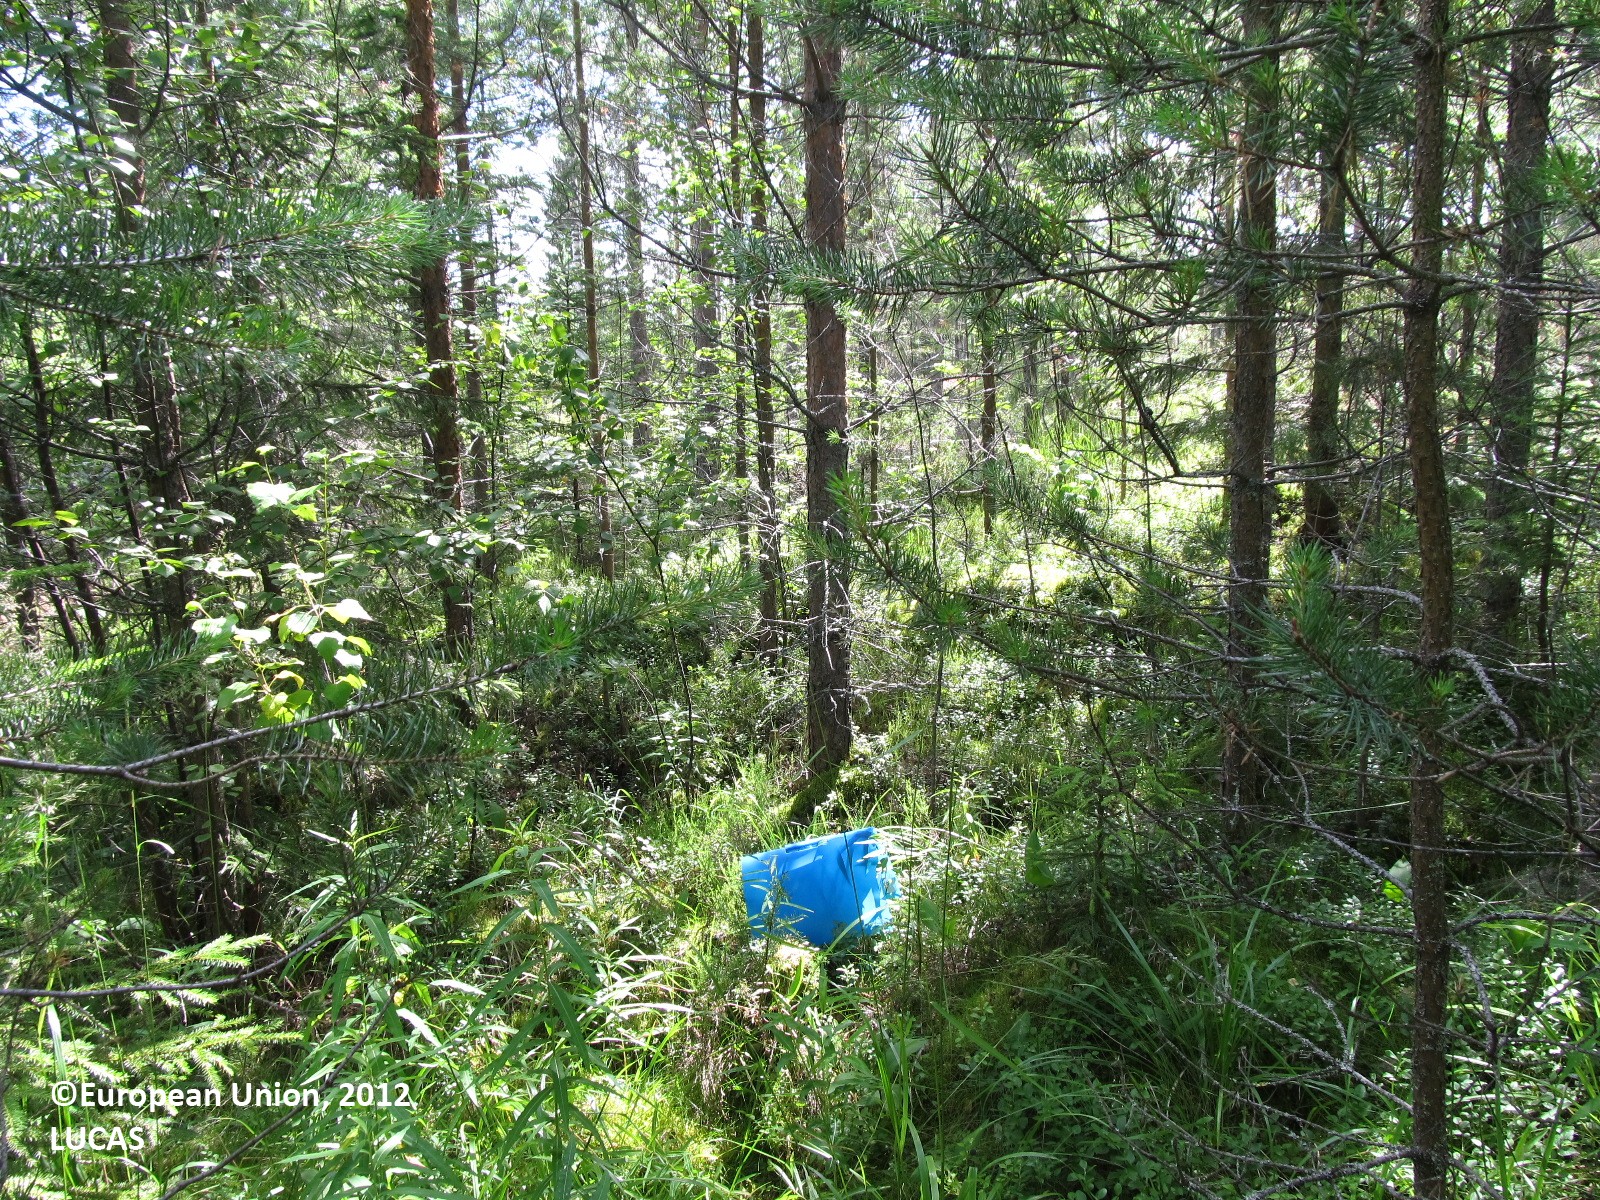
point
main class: Woodland
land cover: Pine dominated mixed woodland
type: boreal forest
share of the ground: 50 - 75 %
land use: Forestry
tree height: > 5 m
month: July
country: FI
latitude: 62.0221
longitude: 27.9377
